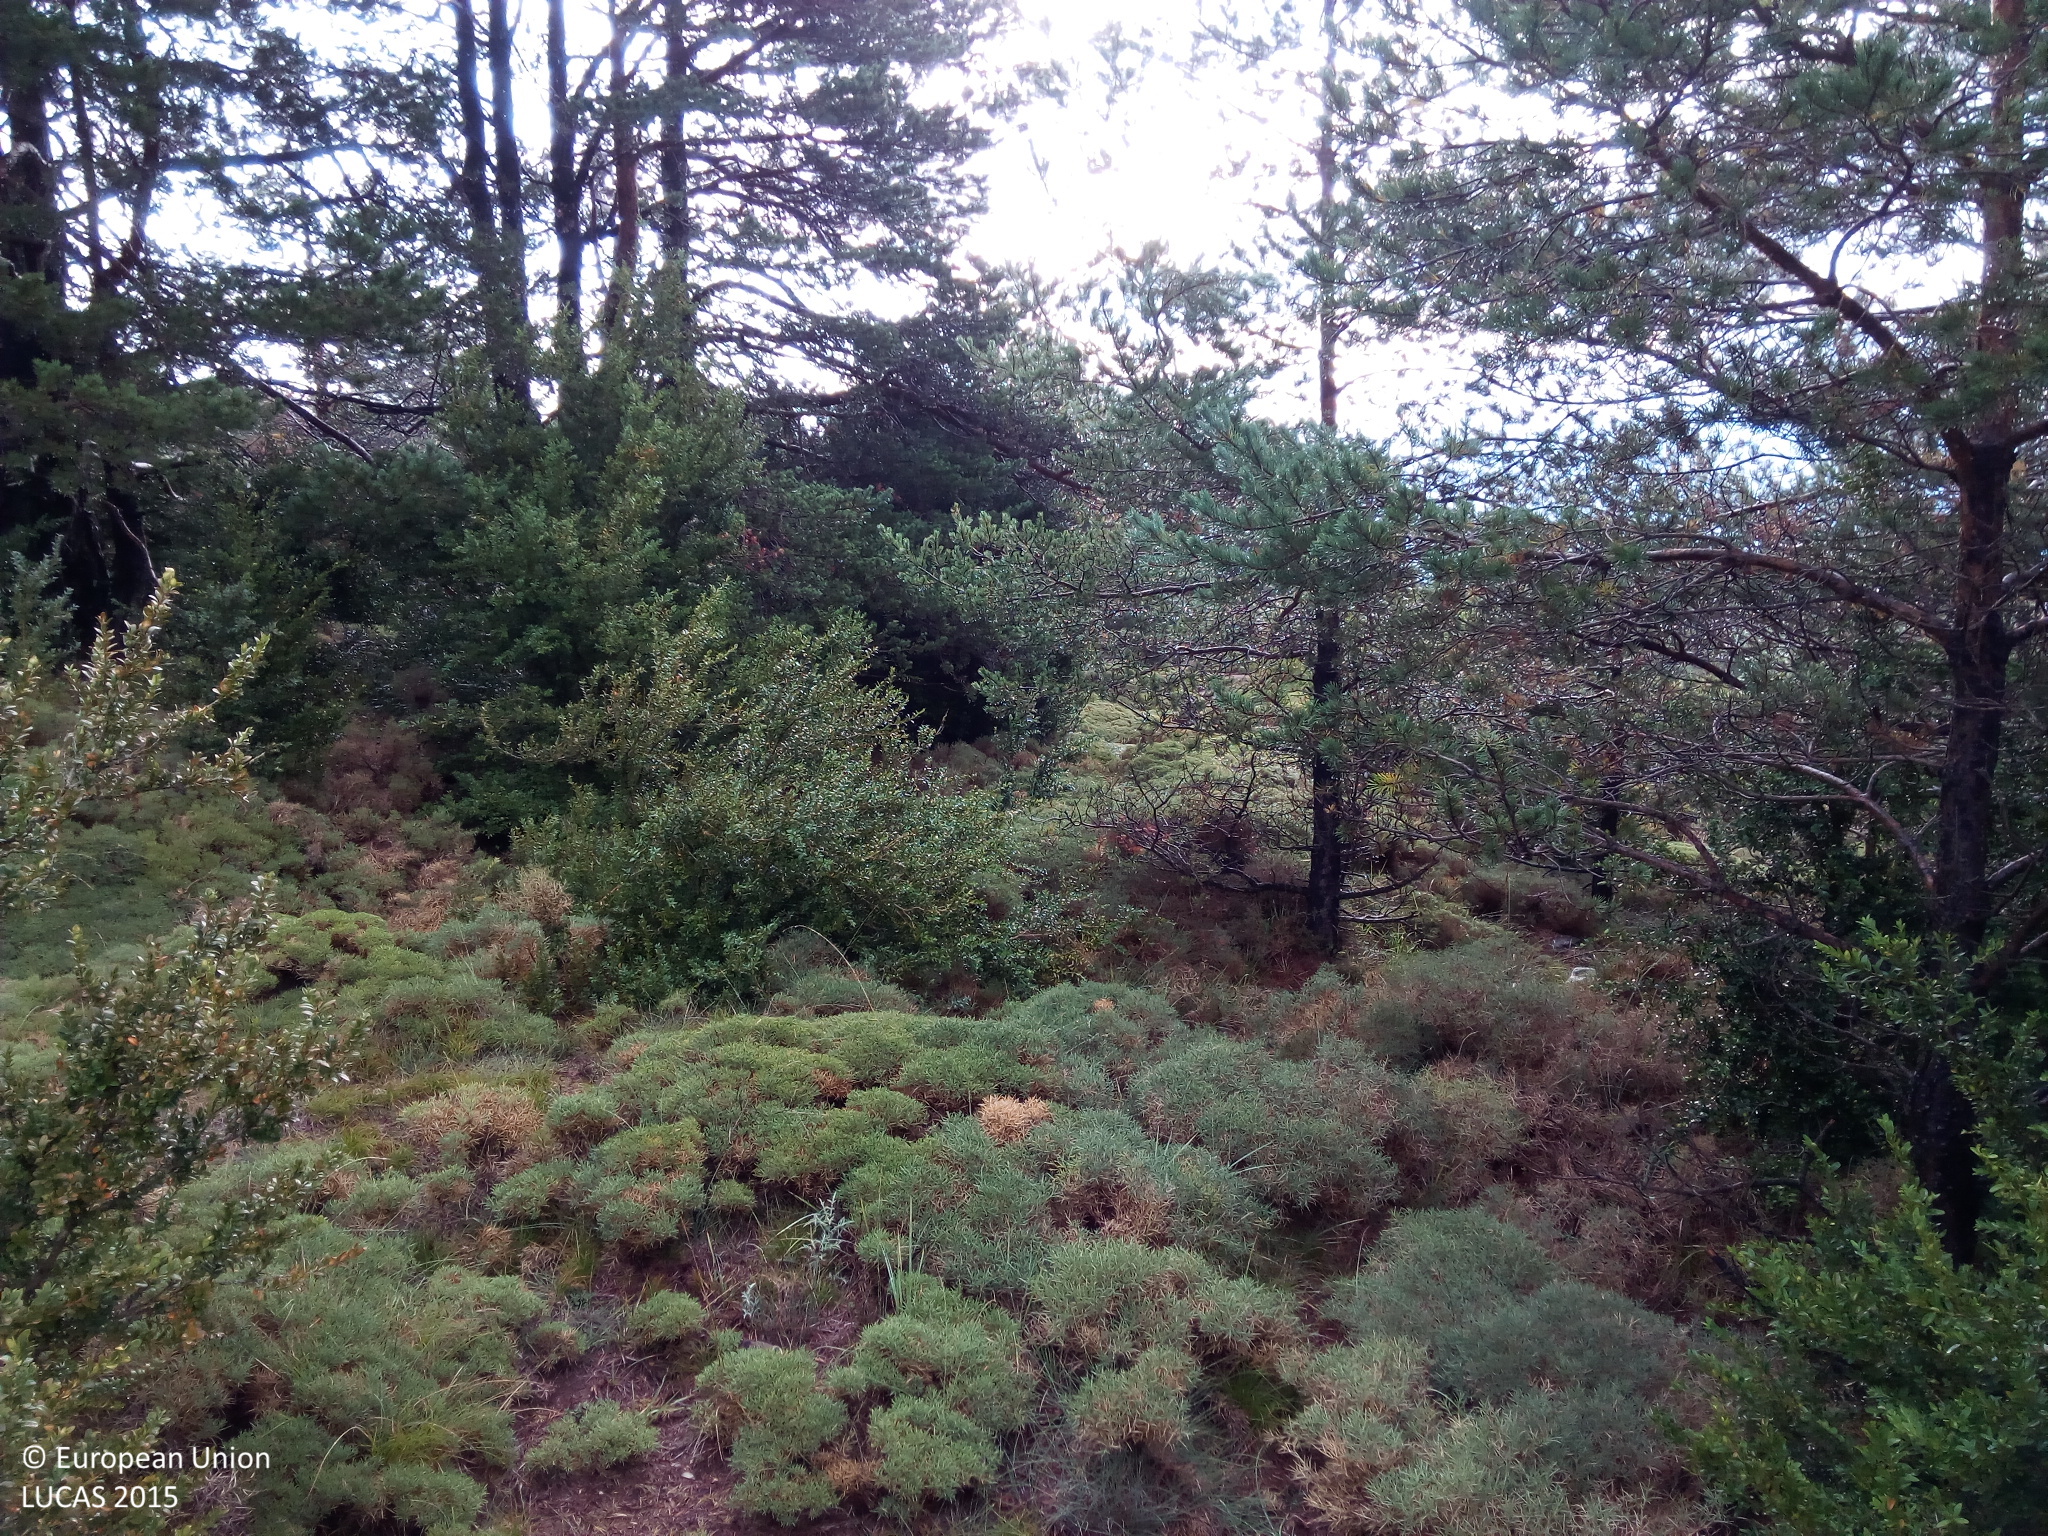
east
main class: Woodland
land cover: Pine dominated coniferous woodland
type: coniferous forest of the mediterranean region
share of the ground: > 75 %
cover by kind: coniferous forest trees 50 %, shrubs 40 %, herbaceous plants 10 %
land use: Agriculture (excluding fallow land and kitchen gardens)
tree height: > 5 m
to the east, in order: Pine dominated coniferous woodland; Shrubland without tree cover; Pine dominated coniferous woodland; Shrubland without tree cover; Pine dominated coniferous woodland
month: September
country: ES
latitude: 42.4103
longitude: -0.0226
